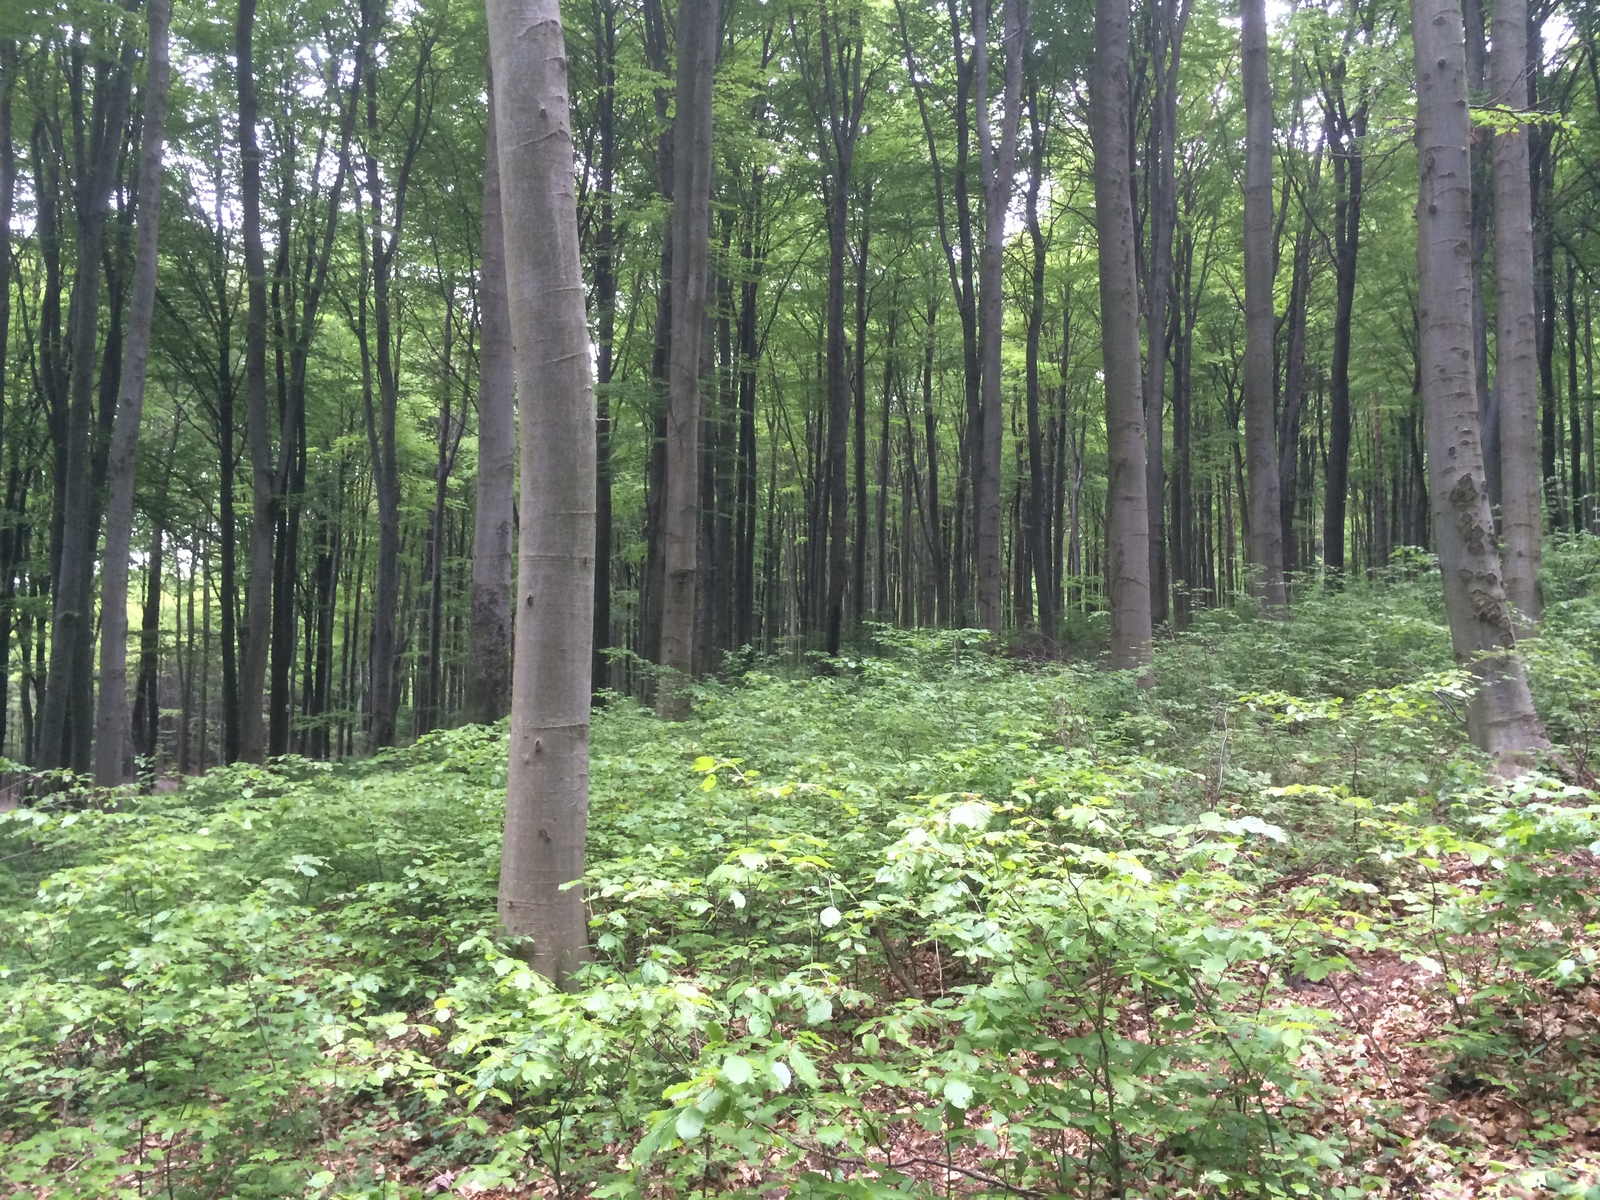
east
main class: Woodland
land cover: Broadleaved woodland
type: beech forest
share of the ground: > 75 %
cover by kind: broadleaved forest trees 100 %
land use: Forestry
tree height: > 5 m
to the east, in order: Broadleaved woodland; Tracks; Broadleaved woodland; Rye
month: May
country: AT
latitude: 48.0497
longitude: 16.1885
